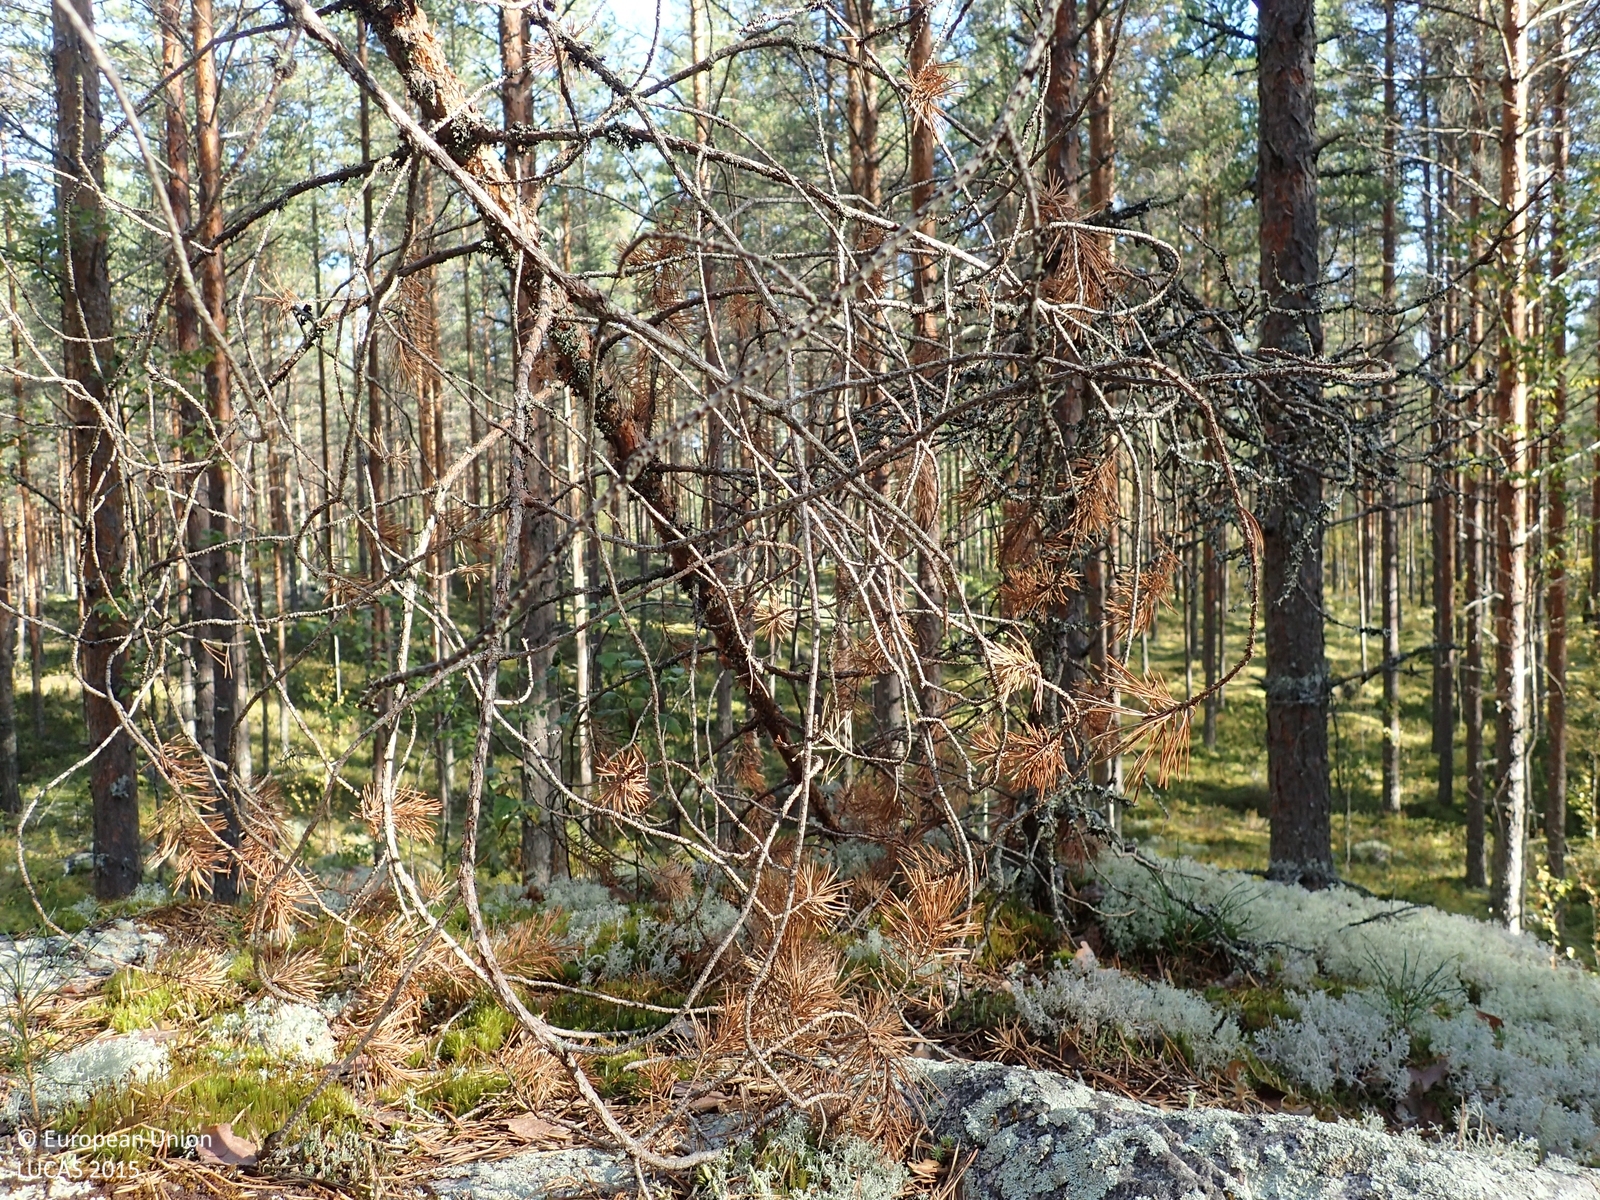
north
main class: Woodland
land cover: Pine dominated coniferous woodland
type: boreal forest
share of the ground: > 75 %
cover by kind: coniferous forest trees 65 %, shrubs 15 %, broadleaved forest trees 10 %, lichens and mosses 5 %, consolidated bare surface 5 %
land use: Forestry
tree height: > 5 m
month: September
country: FI
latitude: 62.9310
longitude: 25.2891
